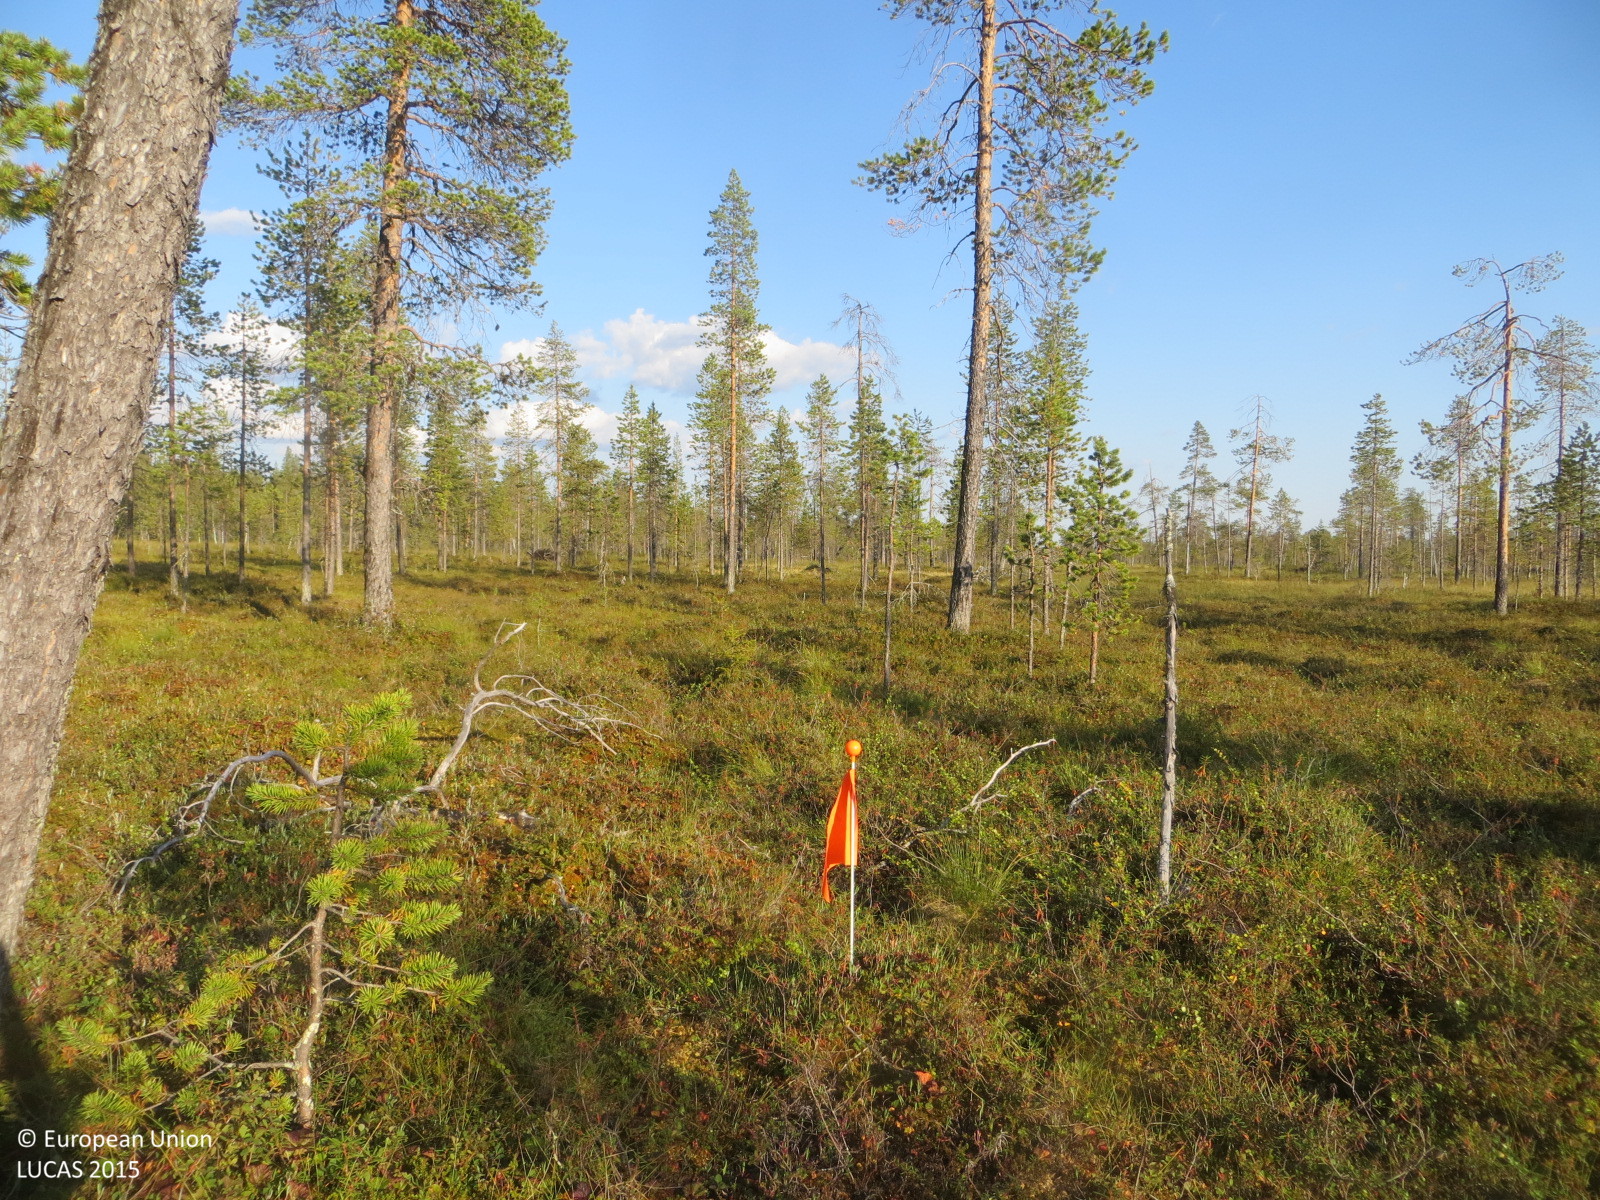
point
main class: Woodland
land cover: Pine dominated coniferous woodland
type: mire and swamp forests
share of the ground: 10 - 25 %
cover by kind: shrubs 60 %, coniferous forest trees 20 %, herbaceous plants 20 %
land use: Amenities, museums, leisure
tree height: > 5 m
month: August
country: FI
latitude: 67.7876
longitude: 24.3169
